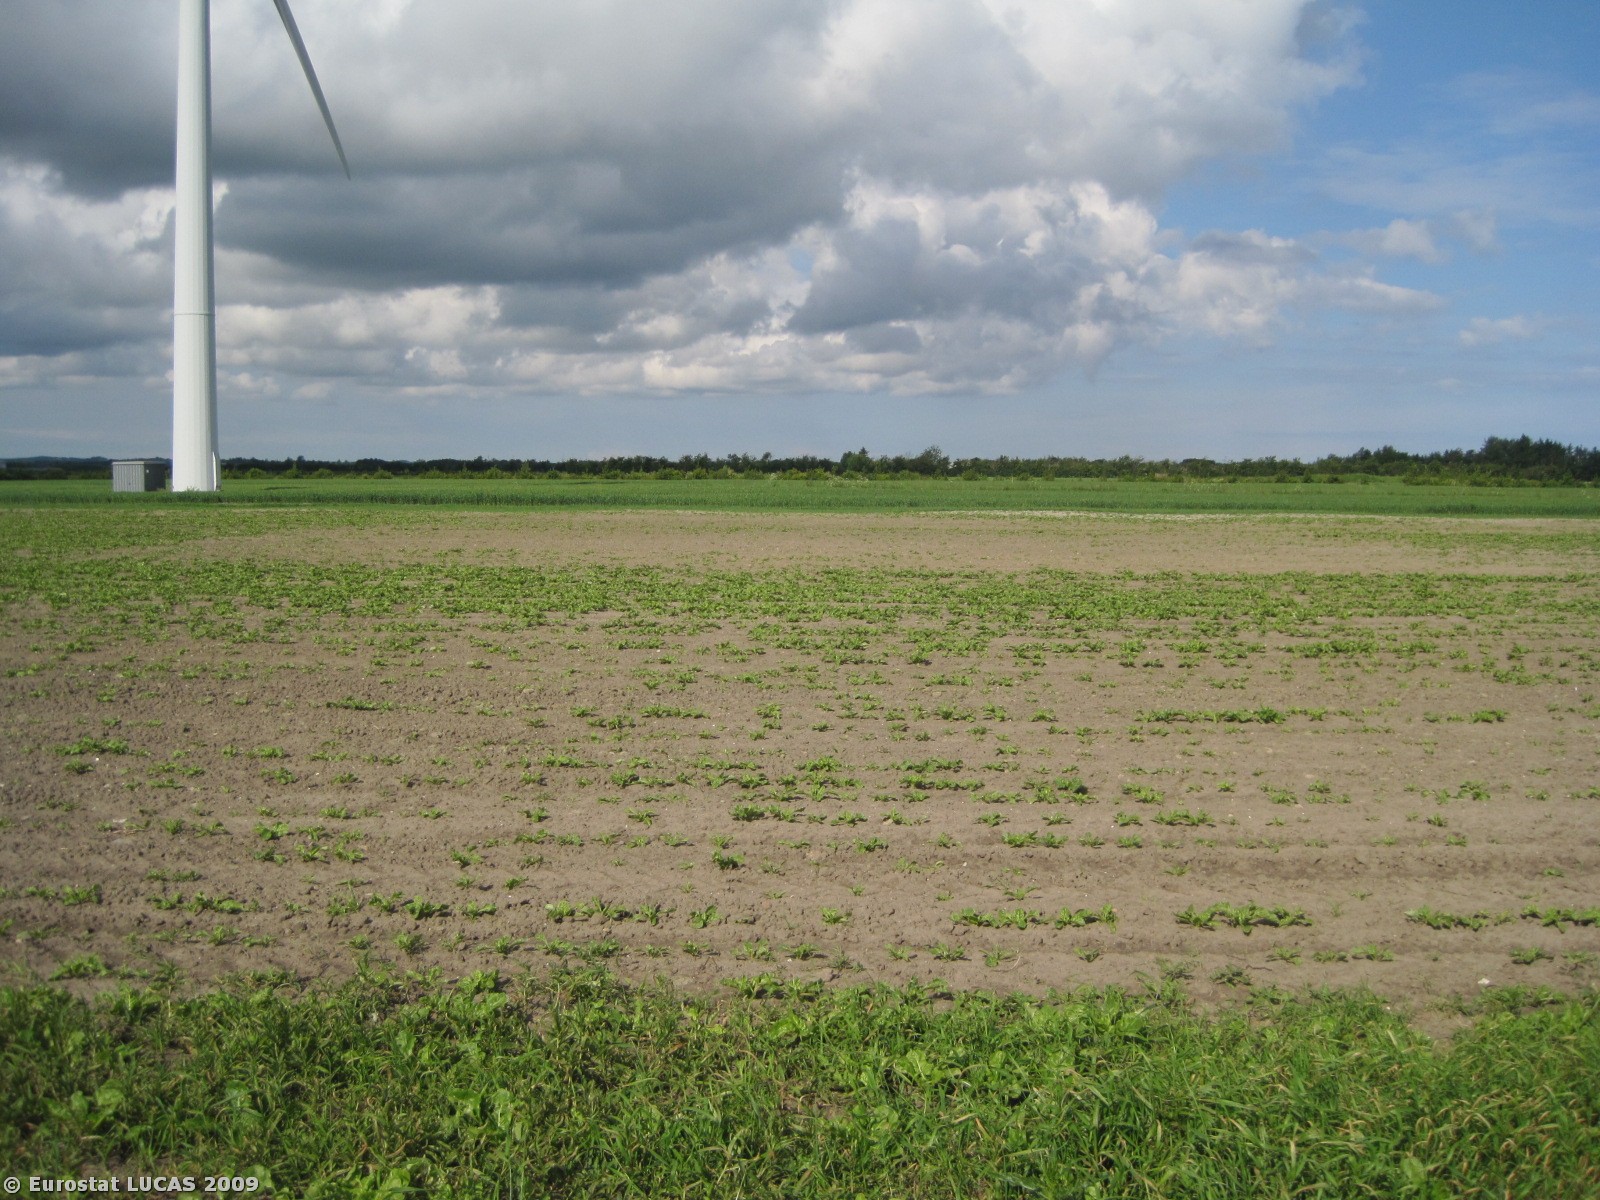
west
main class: Cropland
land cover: Sugar beet
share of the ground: 10 - 25 %
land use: Agriculture (excluding fallow land and kitchen gardens)
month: June
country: DK
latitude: 57.5720
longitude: 10.1502
